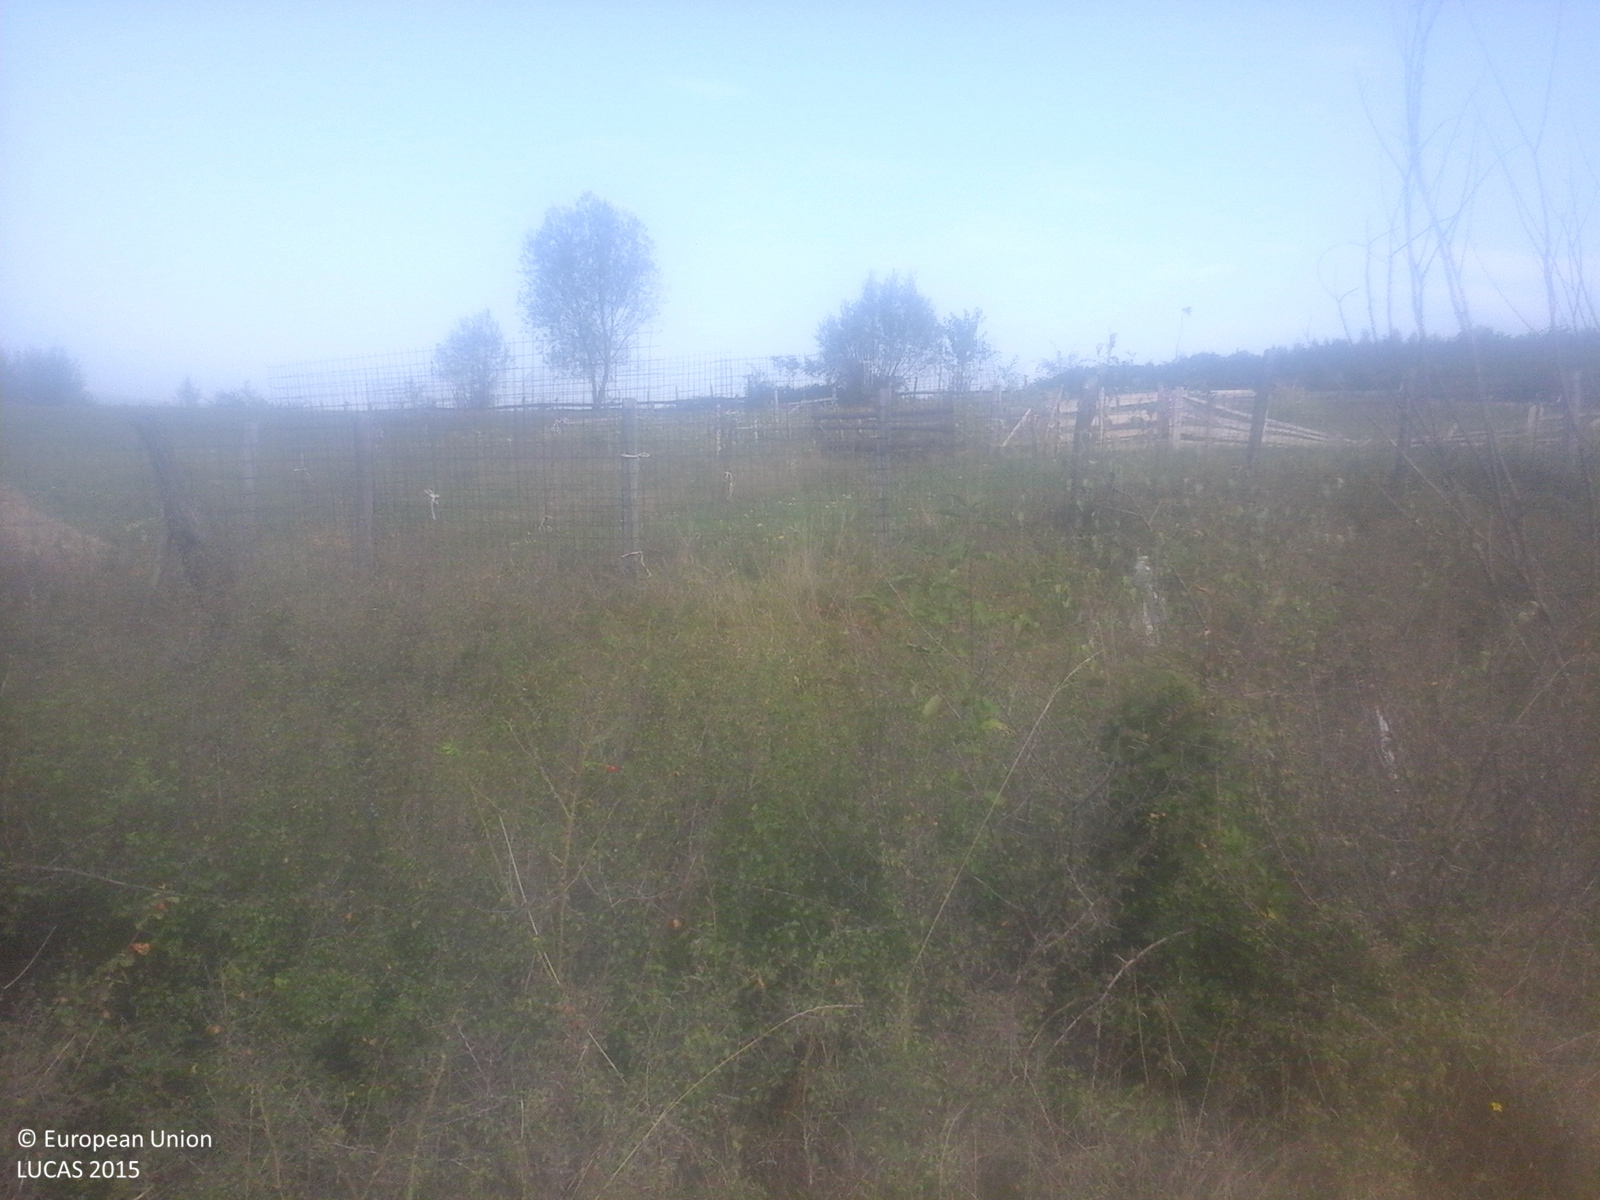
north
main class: Shrubland
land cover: Shrubland with sparse tree cover
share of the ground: > 75 %
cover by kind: herbaceous plants 65 %, shrubs 30 %, broadleaved forest trees 5 %
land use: Semi-natural and natural areas not in use
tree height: < 5 m
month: September
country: RO
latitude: 45.4981
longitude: 22.8607
